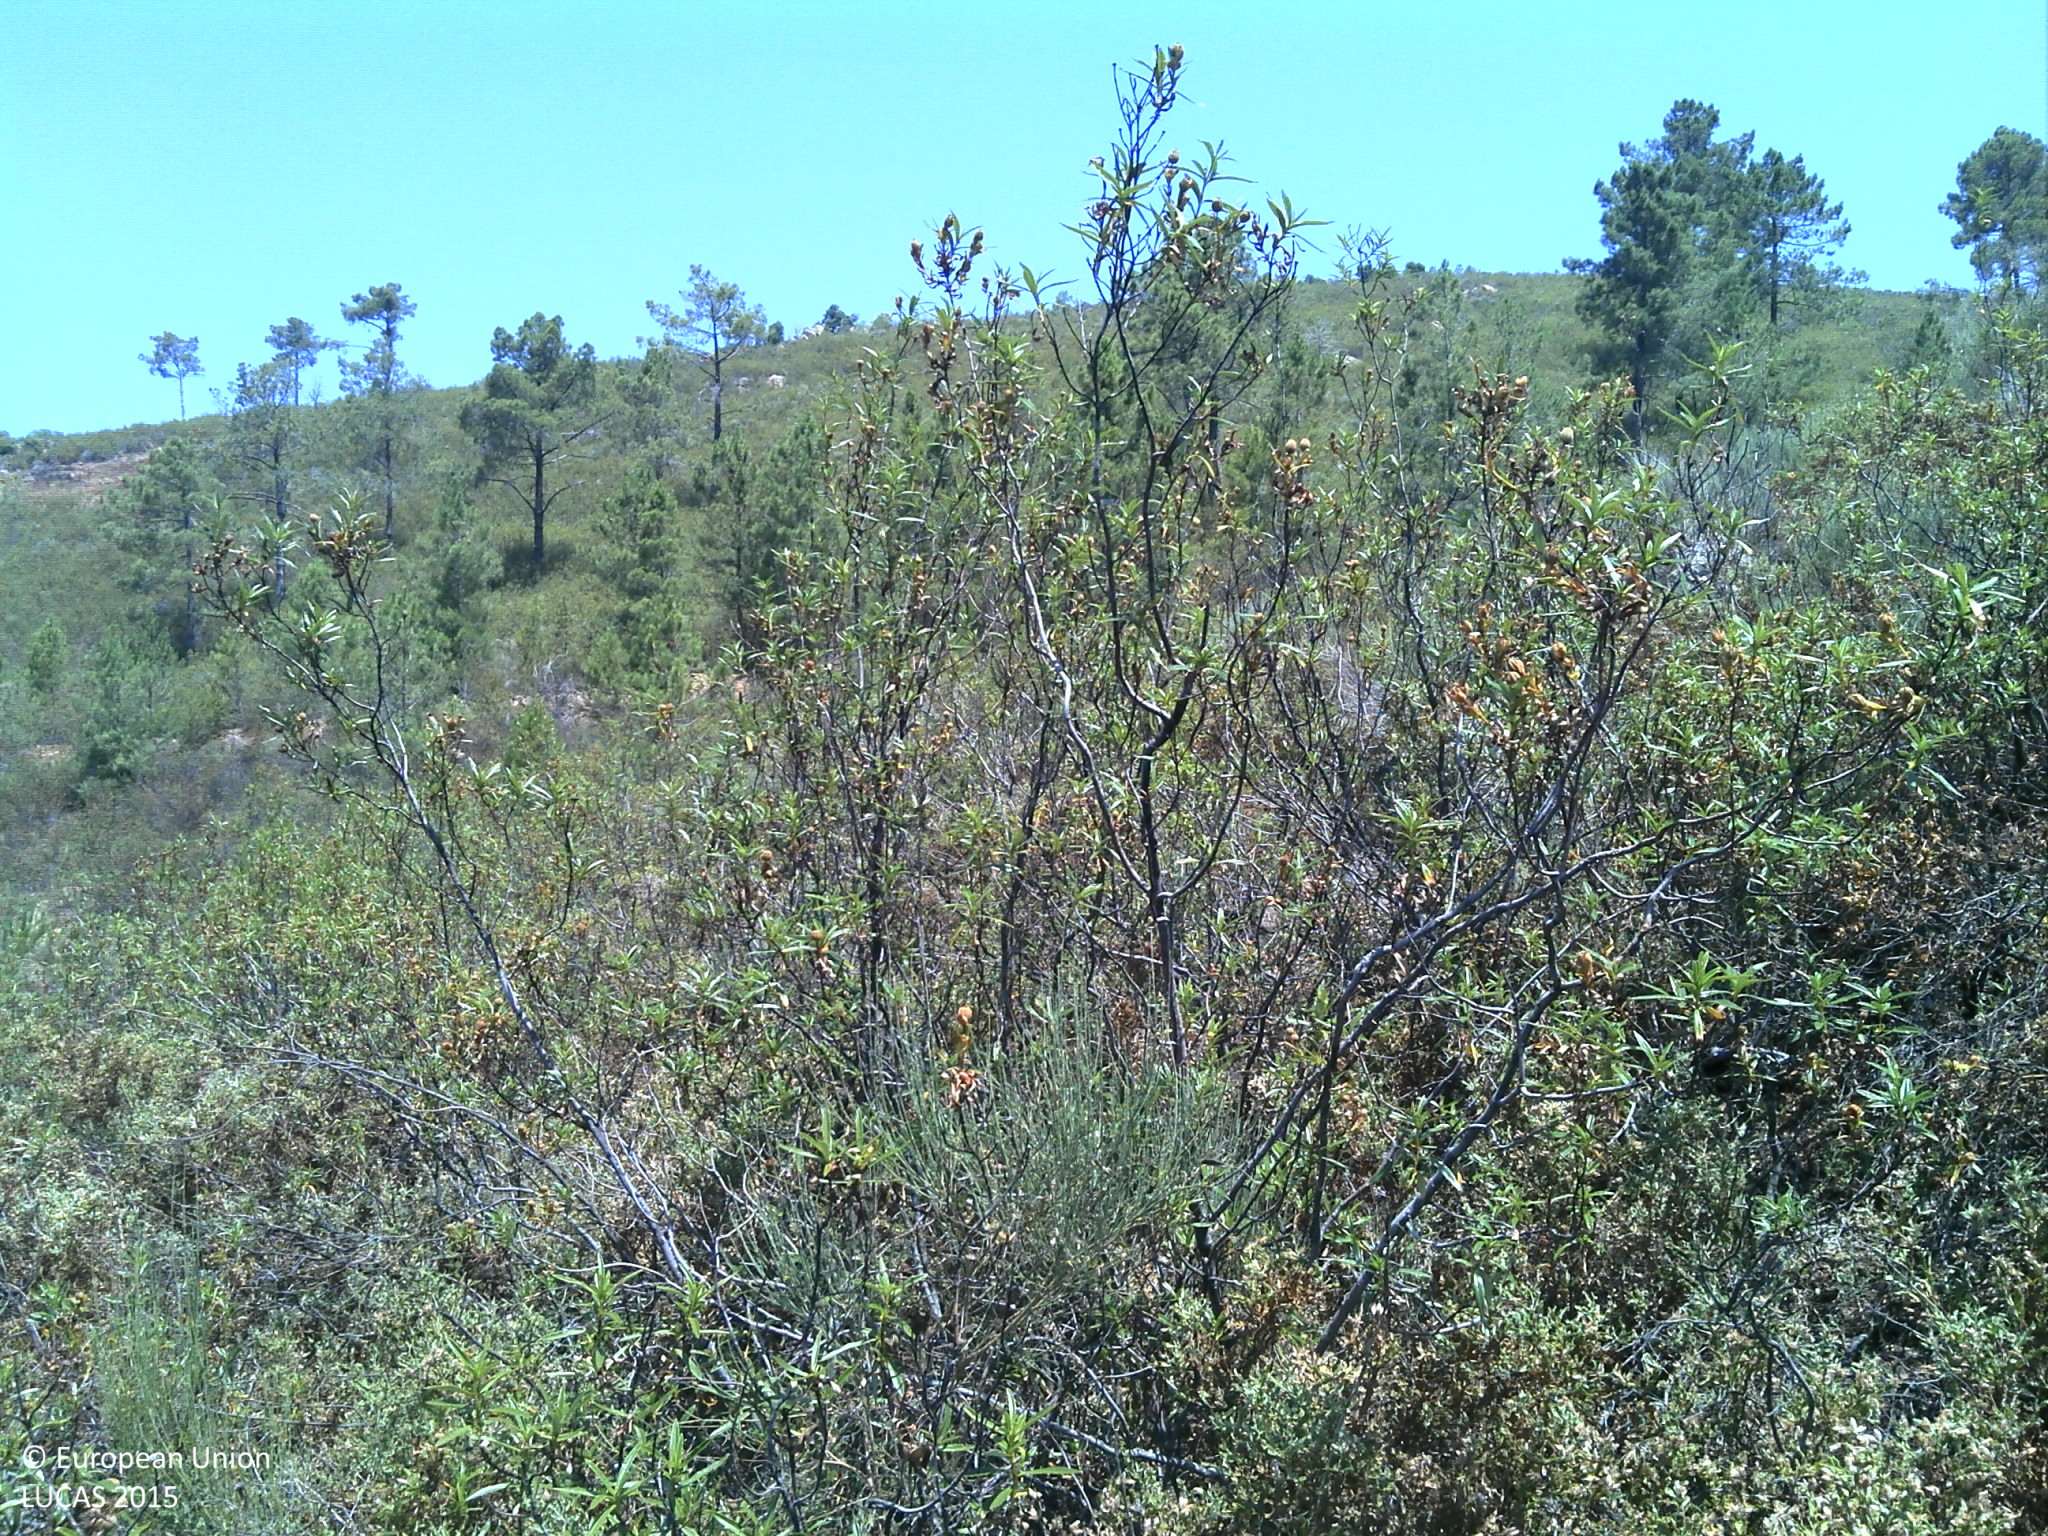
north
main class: Shrubland
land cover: Shrubland without tree cover
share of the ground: > 75 %
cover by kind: shrubs 90 %, consolidated bare surface 5 %, unconsolidated bare surface 5 %
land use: Semi-natural and natural areas not in use
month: June
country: PT
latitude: 41.1558
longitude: -7.0682
